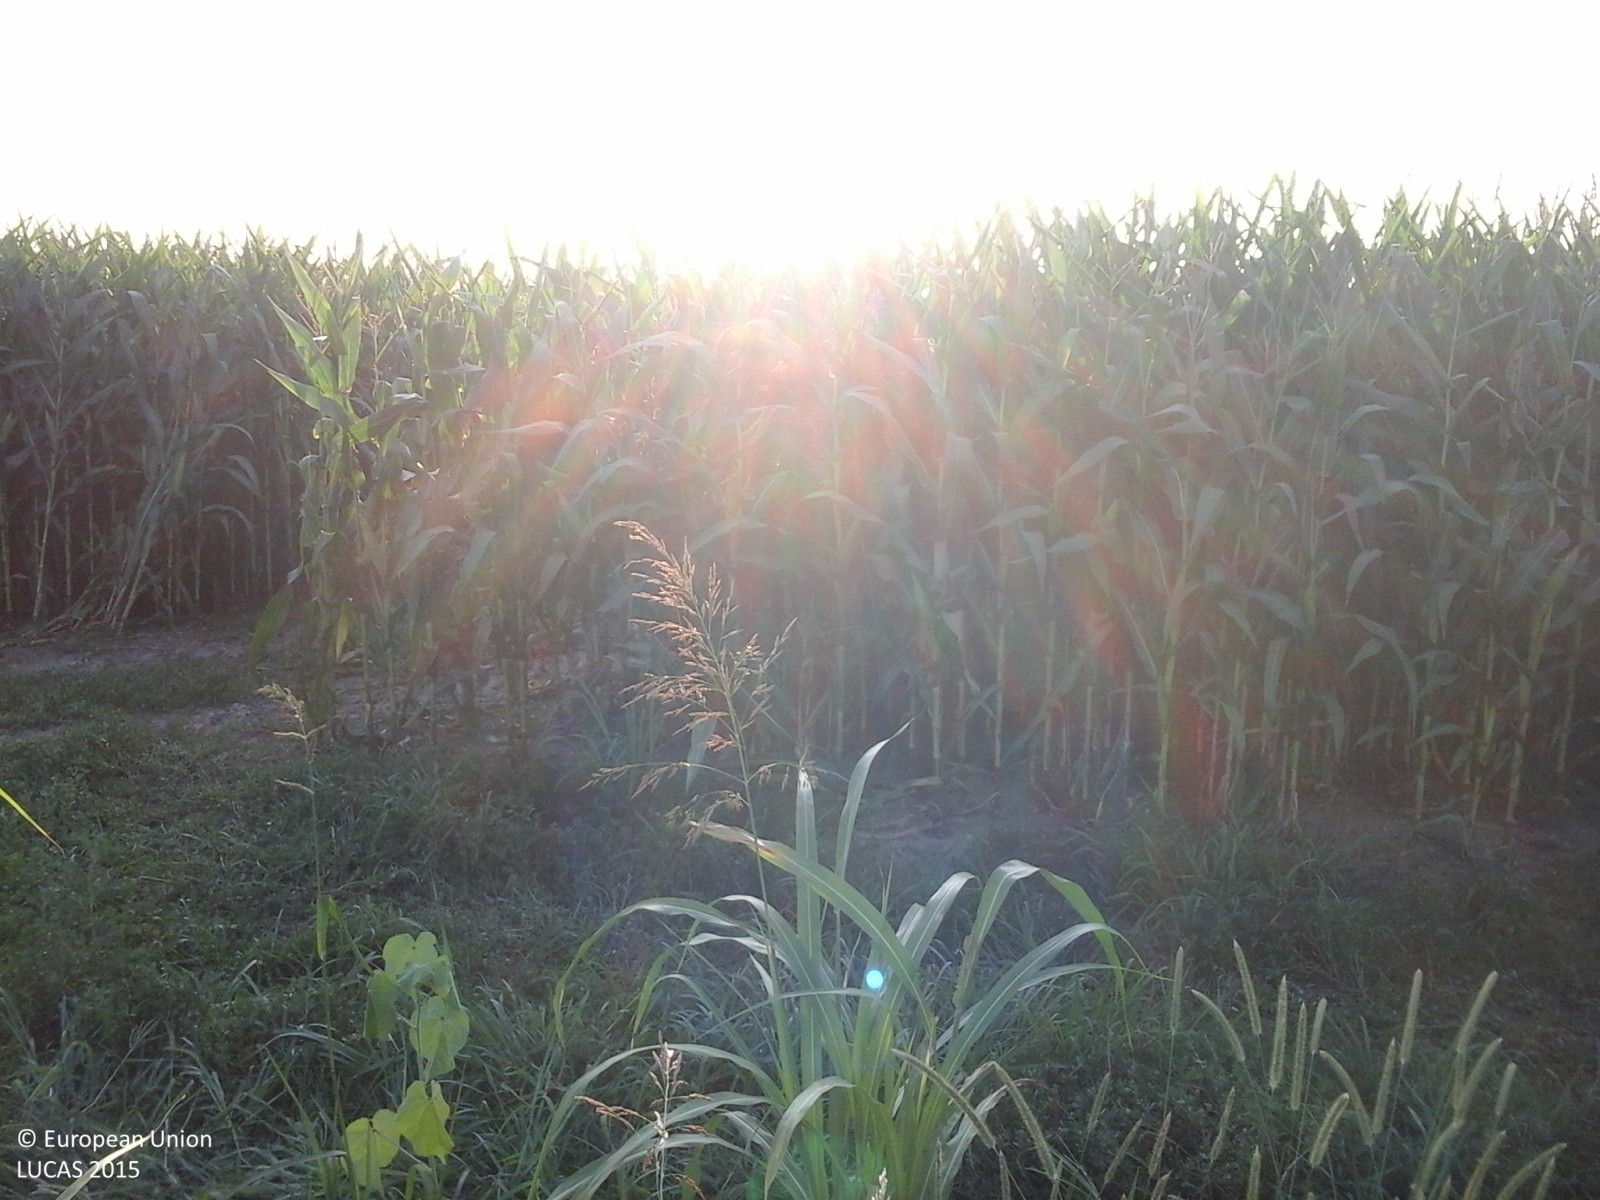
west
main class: Cropland
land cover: Maize
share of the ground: > 75 %
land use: Agriculture (excluding fallow land and kitchen gardens)
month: July
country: IT
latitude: 45.4448
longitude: 8.9151
